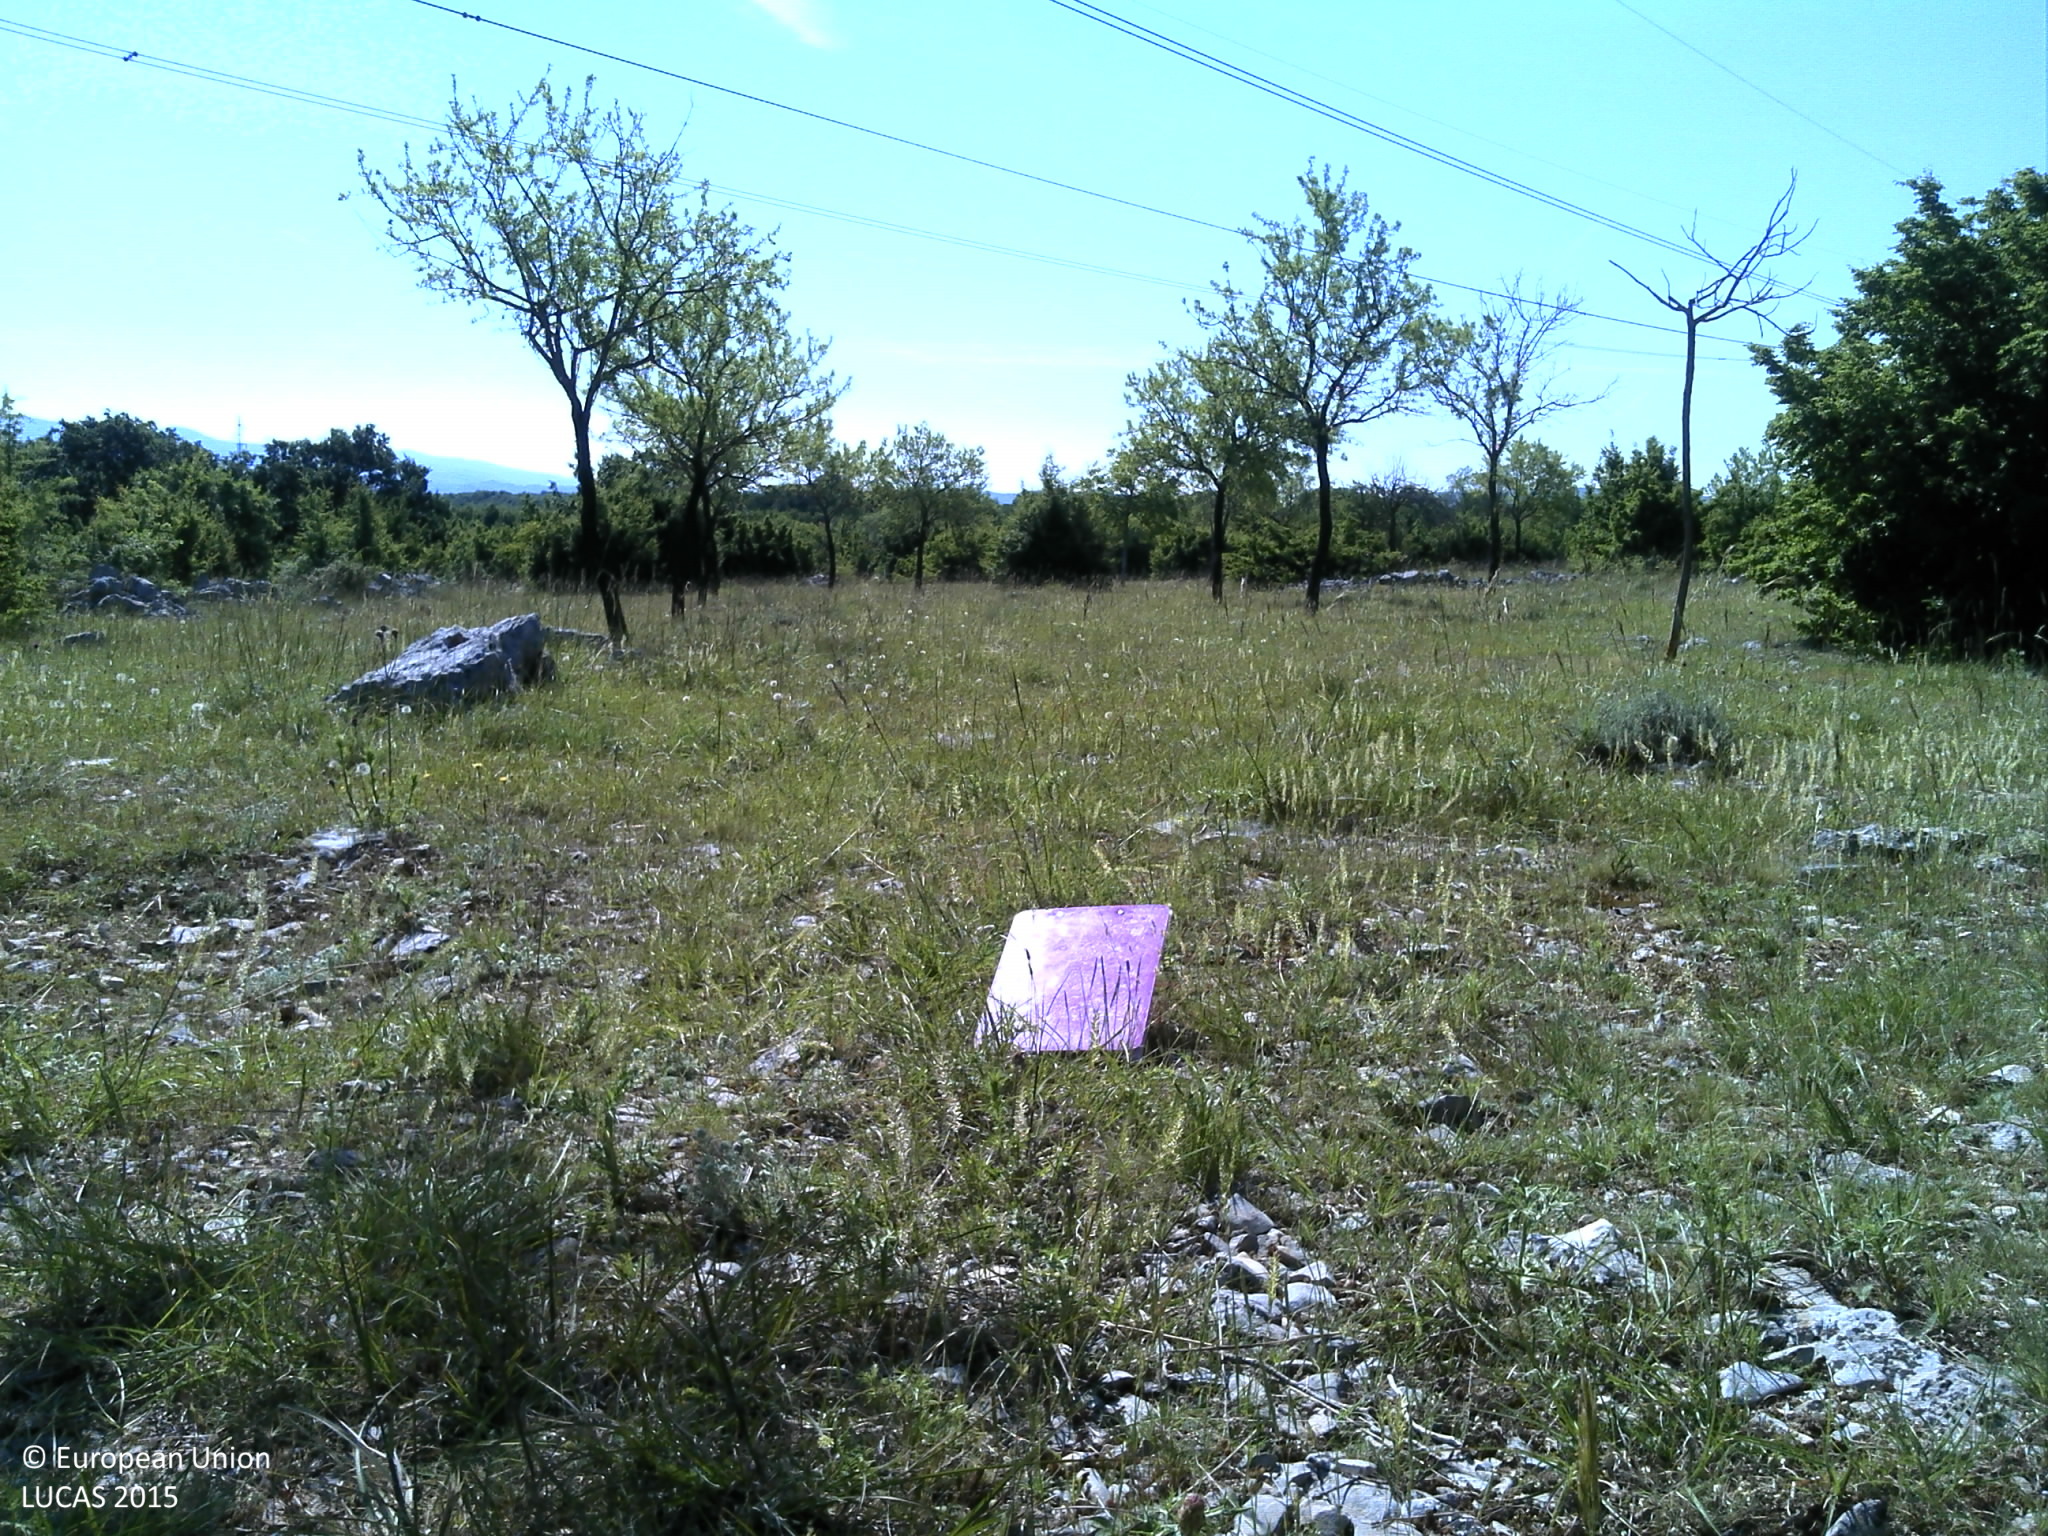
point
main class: Cropland
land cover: Nuts trees
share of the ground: < 10 %
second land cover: Spontaneously vegetated surfaces
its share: > 75 %
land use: Agriculture (excluding fallow land and kitchen gardens)
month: June
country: HR
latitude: 43.7513
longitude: 16.1637
